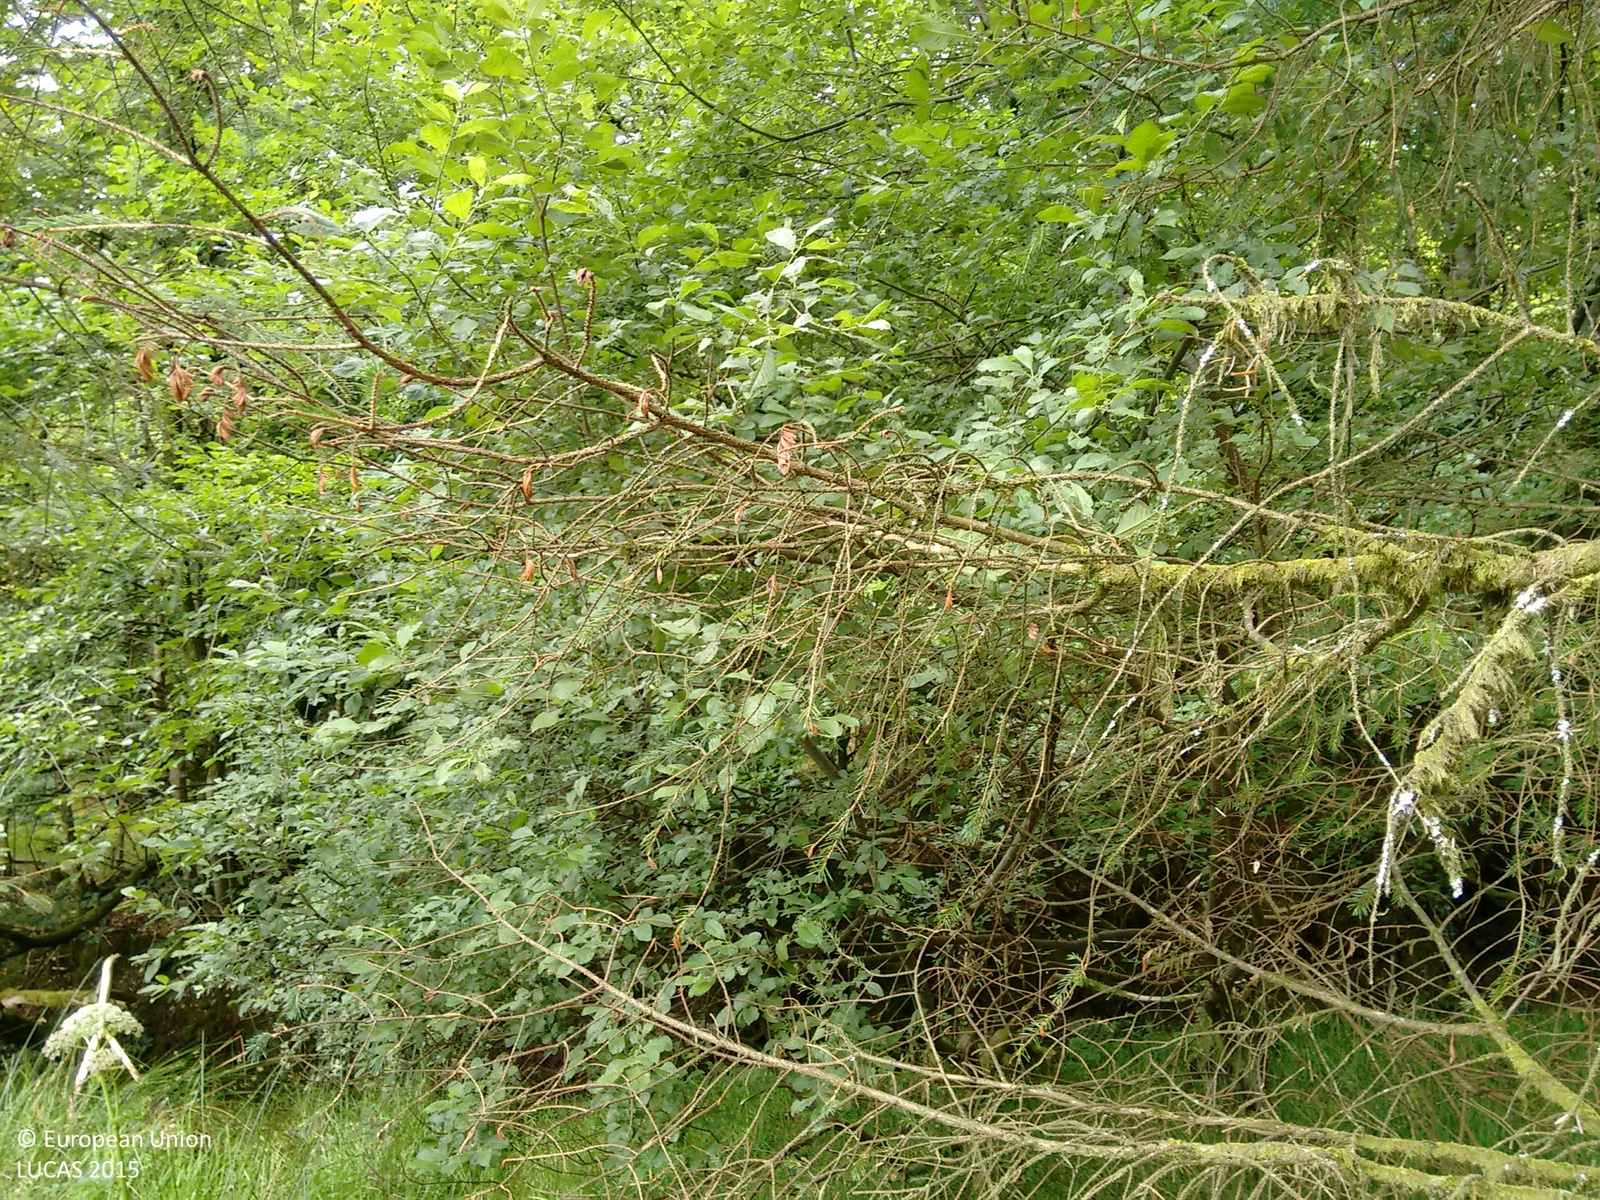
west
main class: Woodland
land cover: Spruce dominated coniferous woodland
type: exotic forest
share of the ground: > 75 %
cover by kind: coniferous forest trees 80 %, broadleaved forest trees 20 %
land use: Forestry
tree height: > 5 m
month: August
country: IE
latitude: 53.0425
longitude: -7.5669
